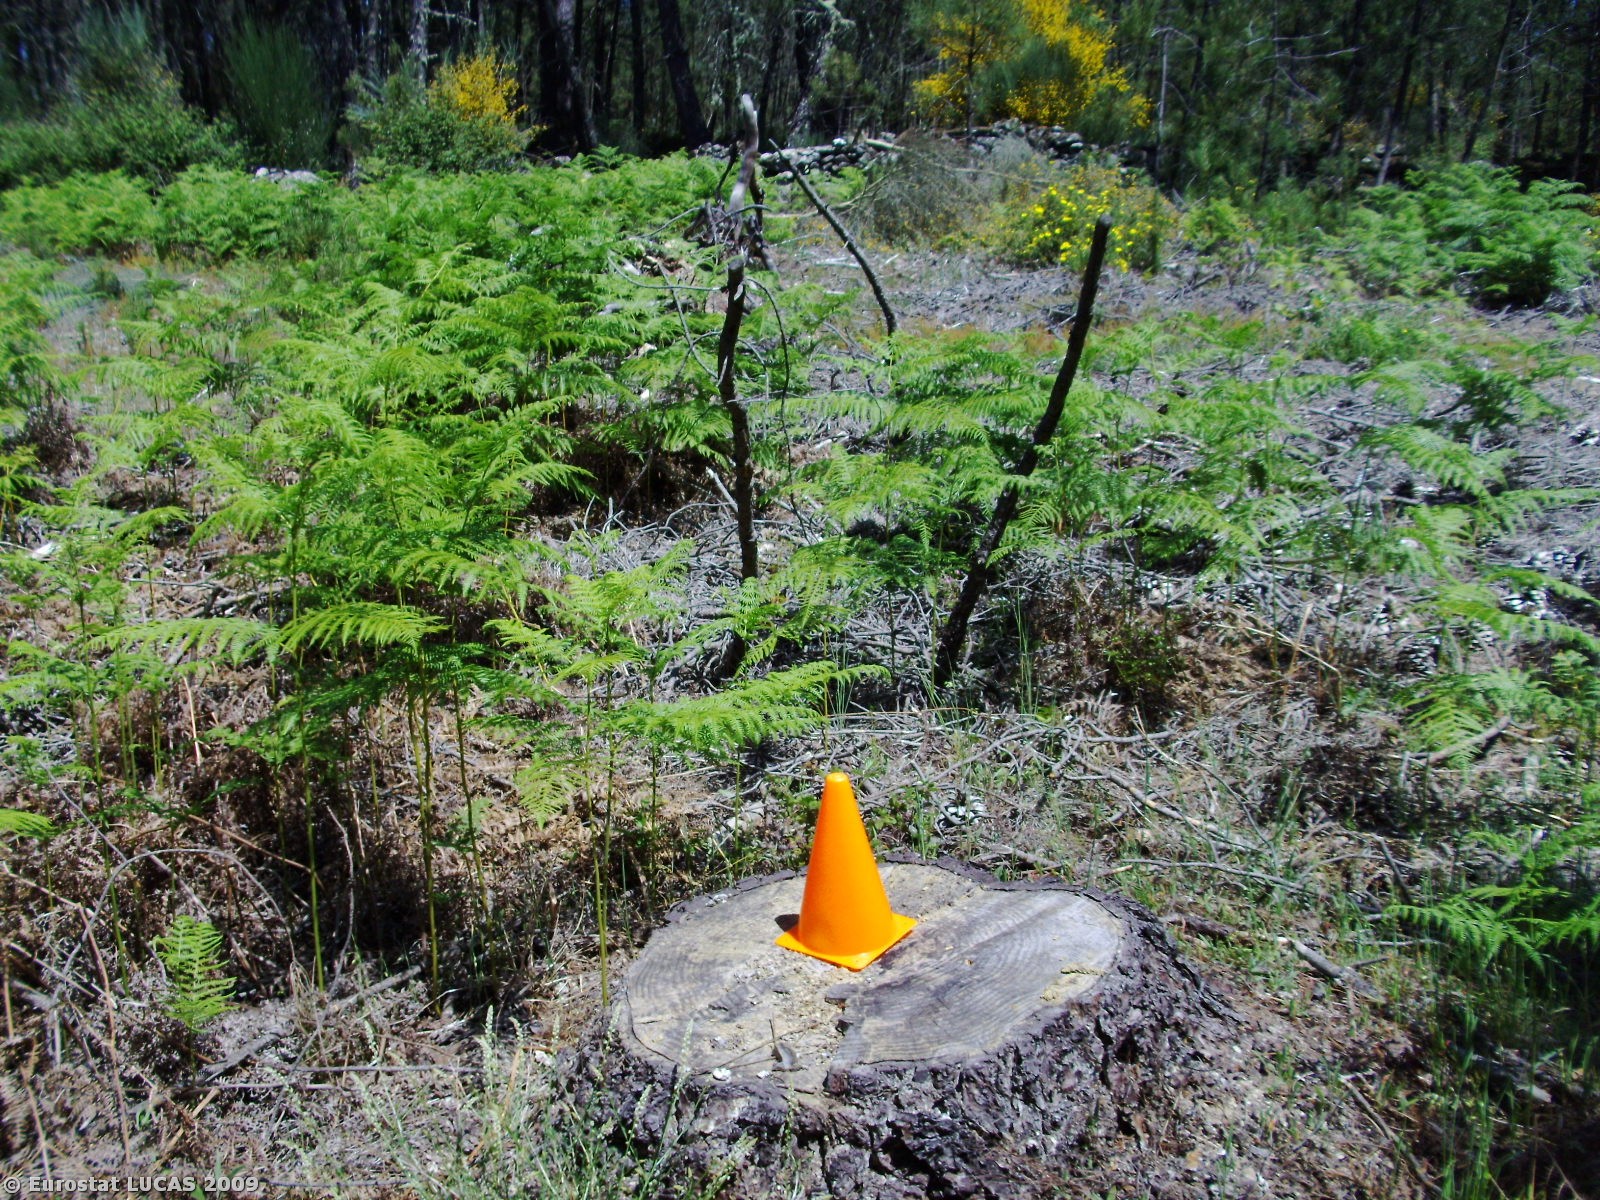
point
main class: Woodland
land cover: Coniferous woodland
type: coniferous forest of the mediterranean region
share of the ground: 10 - 25 %
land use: Forestry
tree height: > 5 m
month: May
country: PT
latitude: 40.7453
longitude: -7.5128
